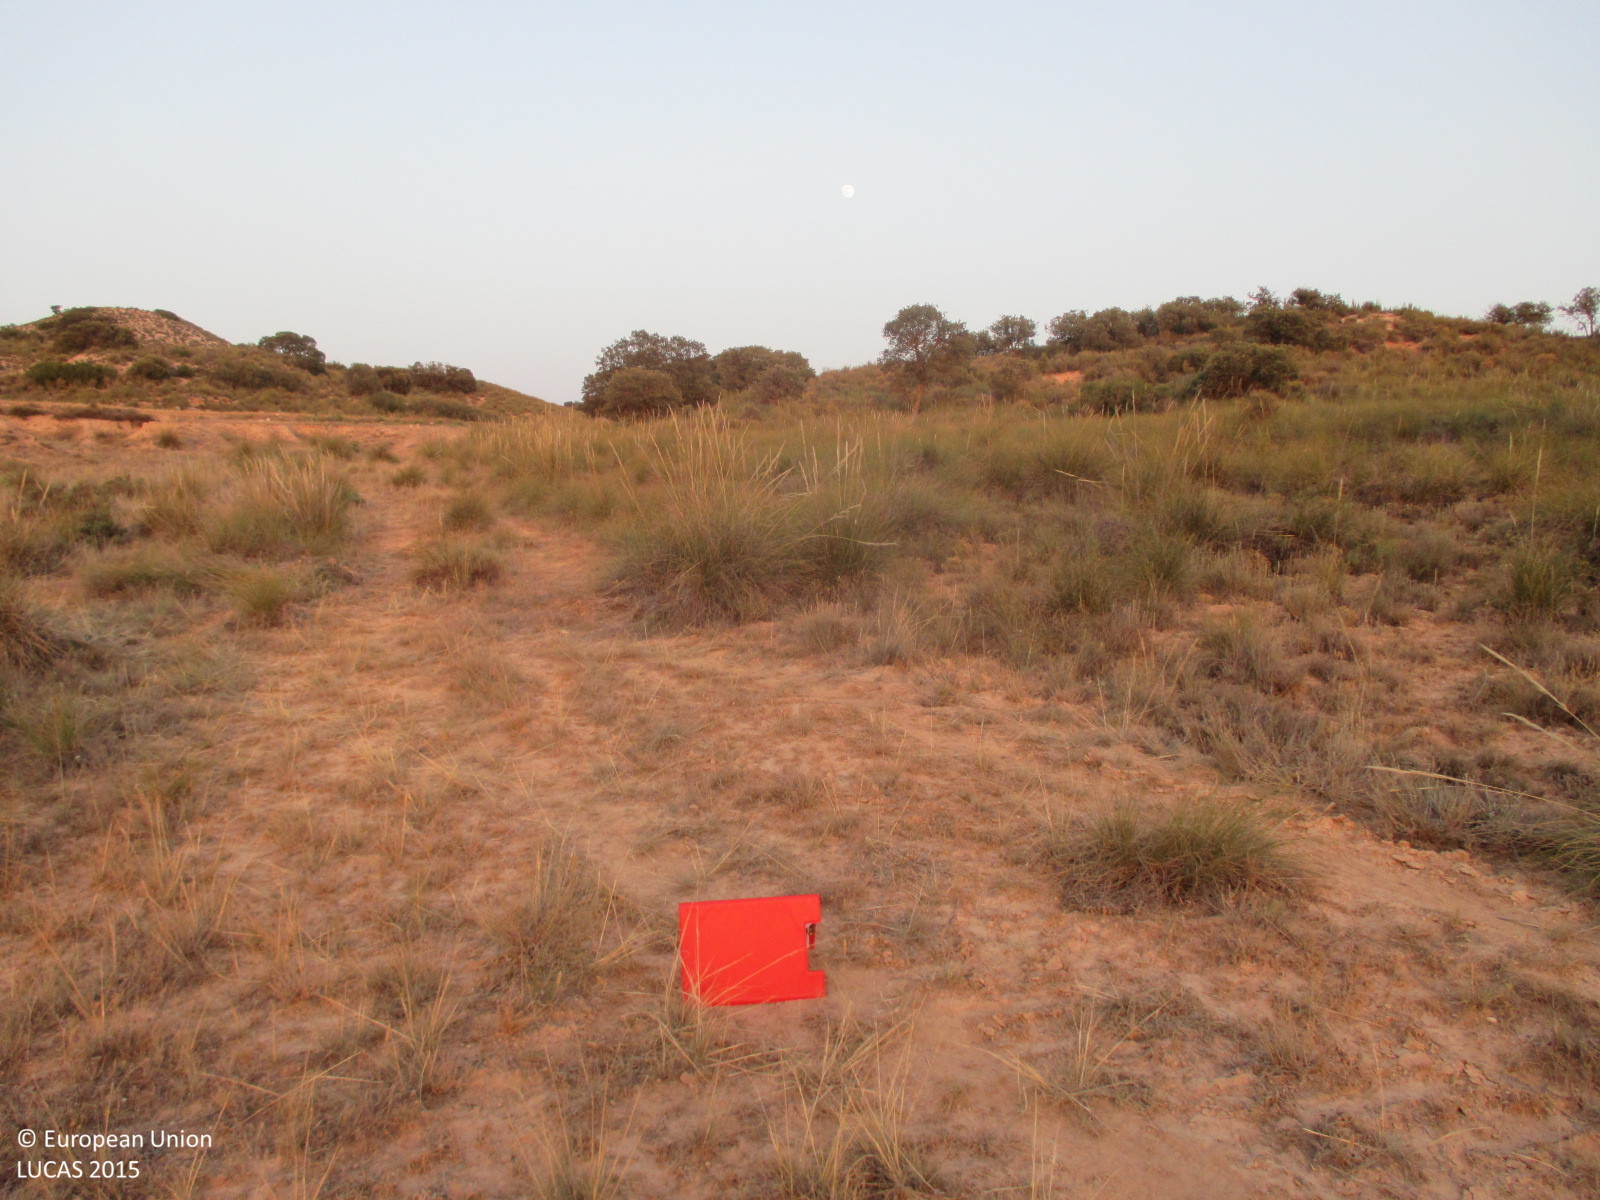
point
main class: Grassland
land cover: Grassland without tree/shrub cover
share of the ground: > 75 %
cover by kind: herbaceous plants 100 %
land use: Semi-natural and natural areas not in use
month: June
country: ES
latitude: 37.7637
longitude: -2.3498
